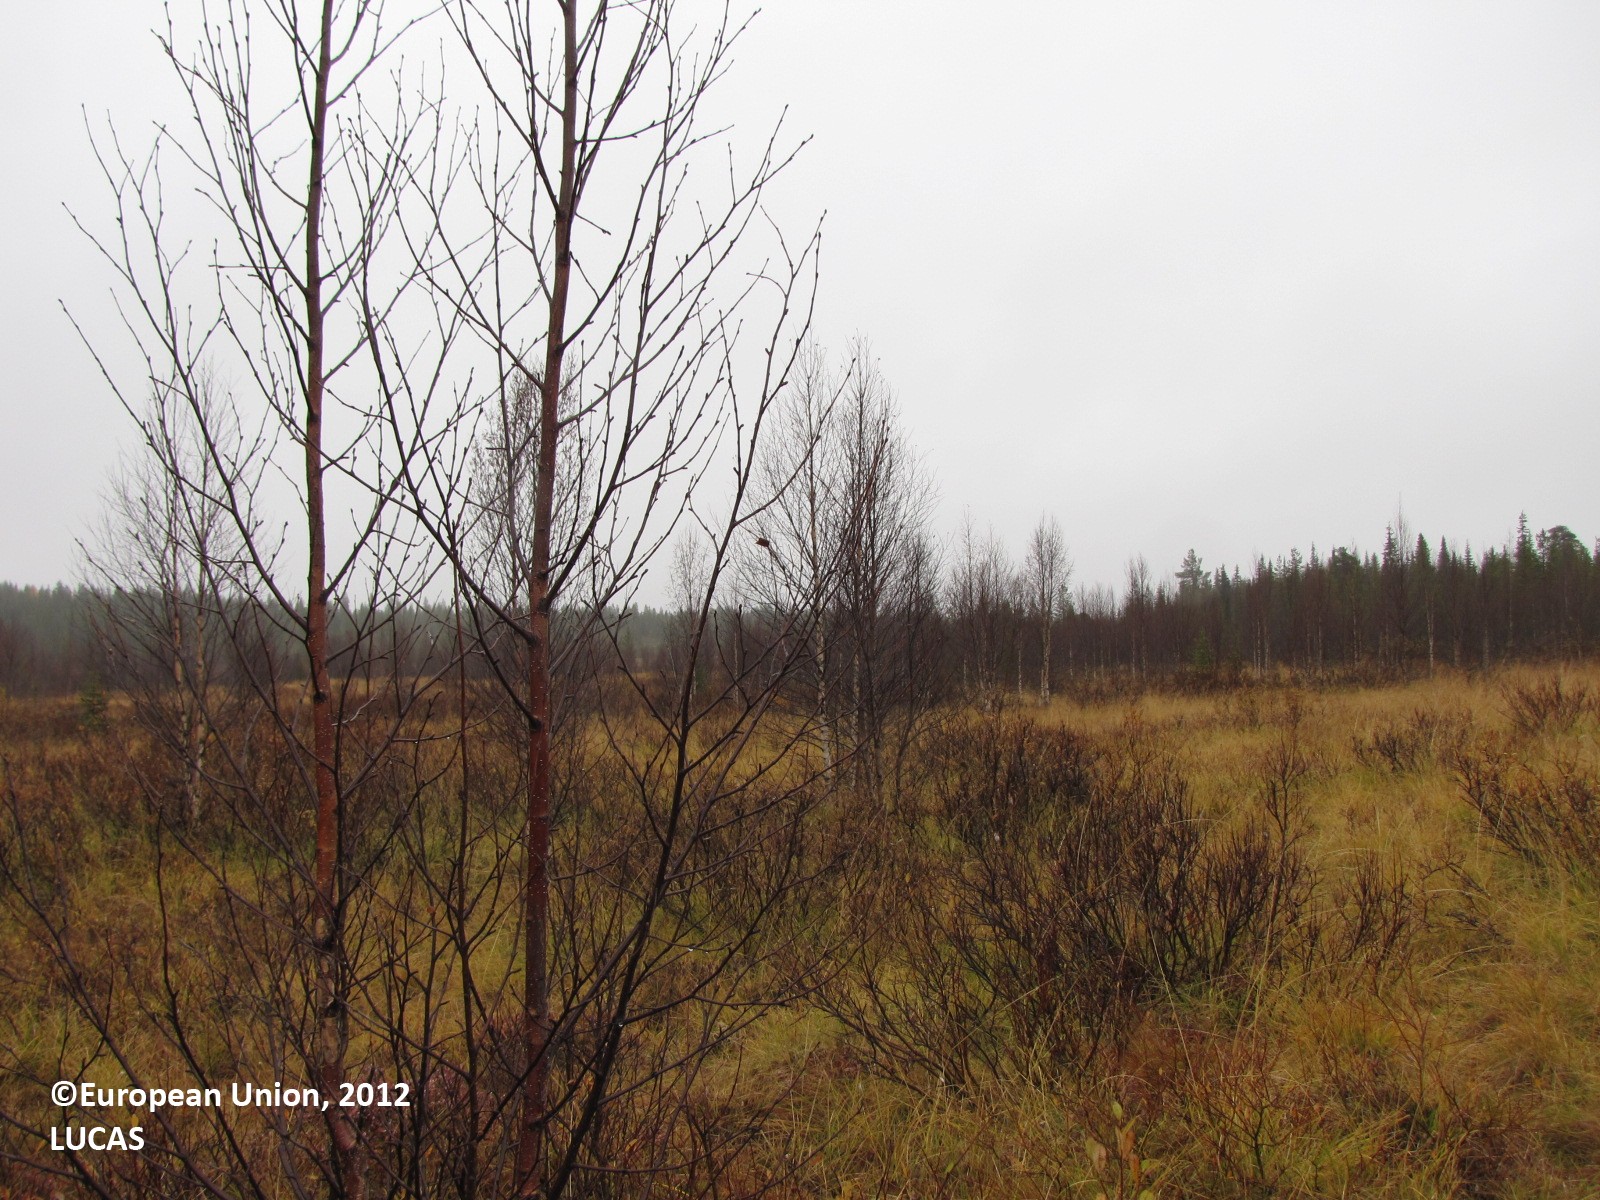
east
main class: Shrubland
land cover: Shrubland with sparse tree cover
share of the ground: 10 - 25 %
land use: Semi-natural and natural areas not in use
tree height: < 5 m
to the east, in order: Shrubland with sparse tree cover; Ditches and canals; Shrubland with sparse tree cover; Abandoned hedges; Ditches and canals; Abandoned hedges; Peatbogs
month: September
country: FI
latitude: 67.7501
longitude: 23.6220
